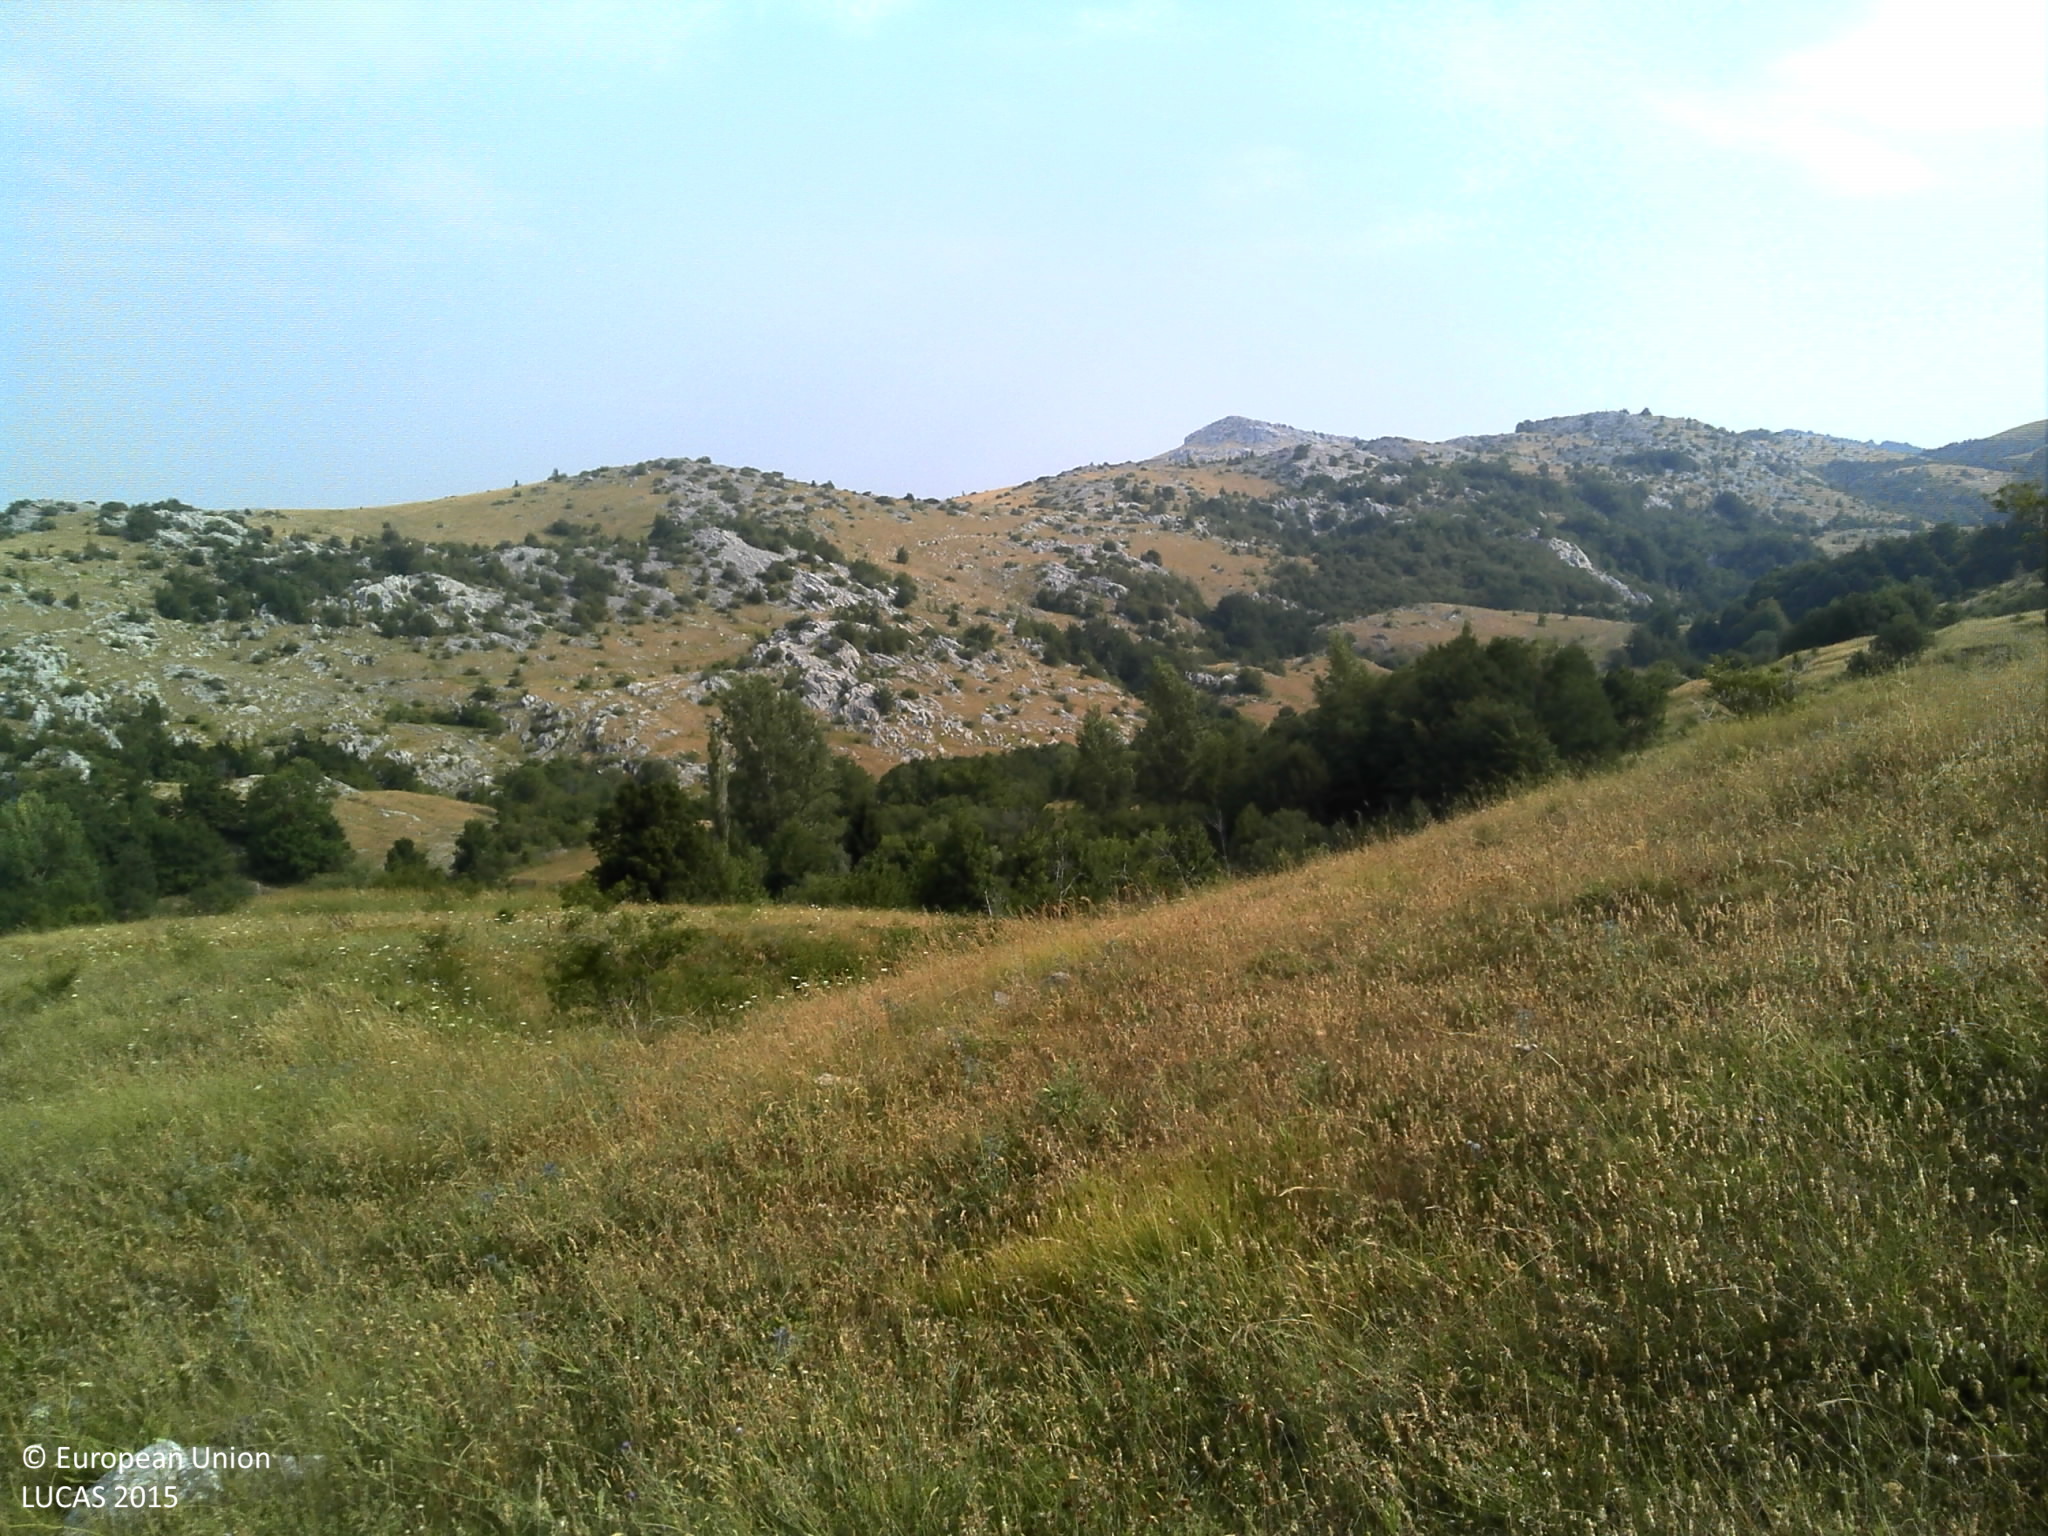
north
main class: Grassland
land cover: Grassland without tree/shrub cover
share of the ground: > 75 %
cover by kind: herbaceous plants 90 %, shrubs 5 %, consolidated bare surface 5 %
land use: Abandoned areas
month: July
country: HR
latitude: 44.3231
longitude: 15.9744
